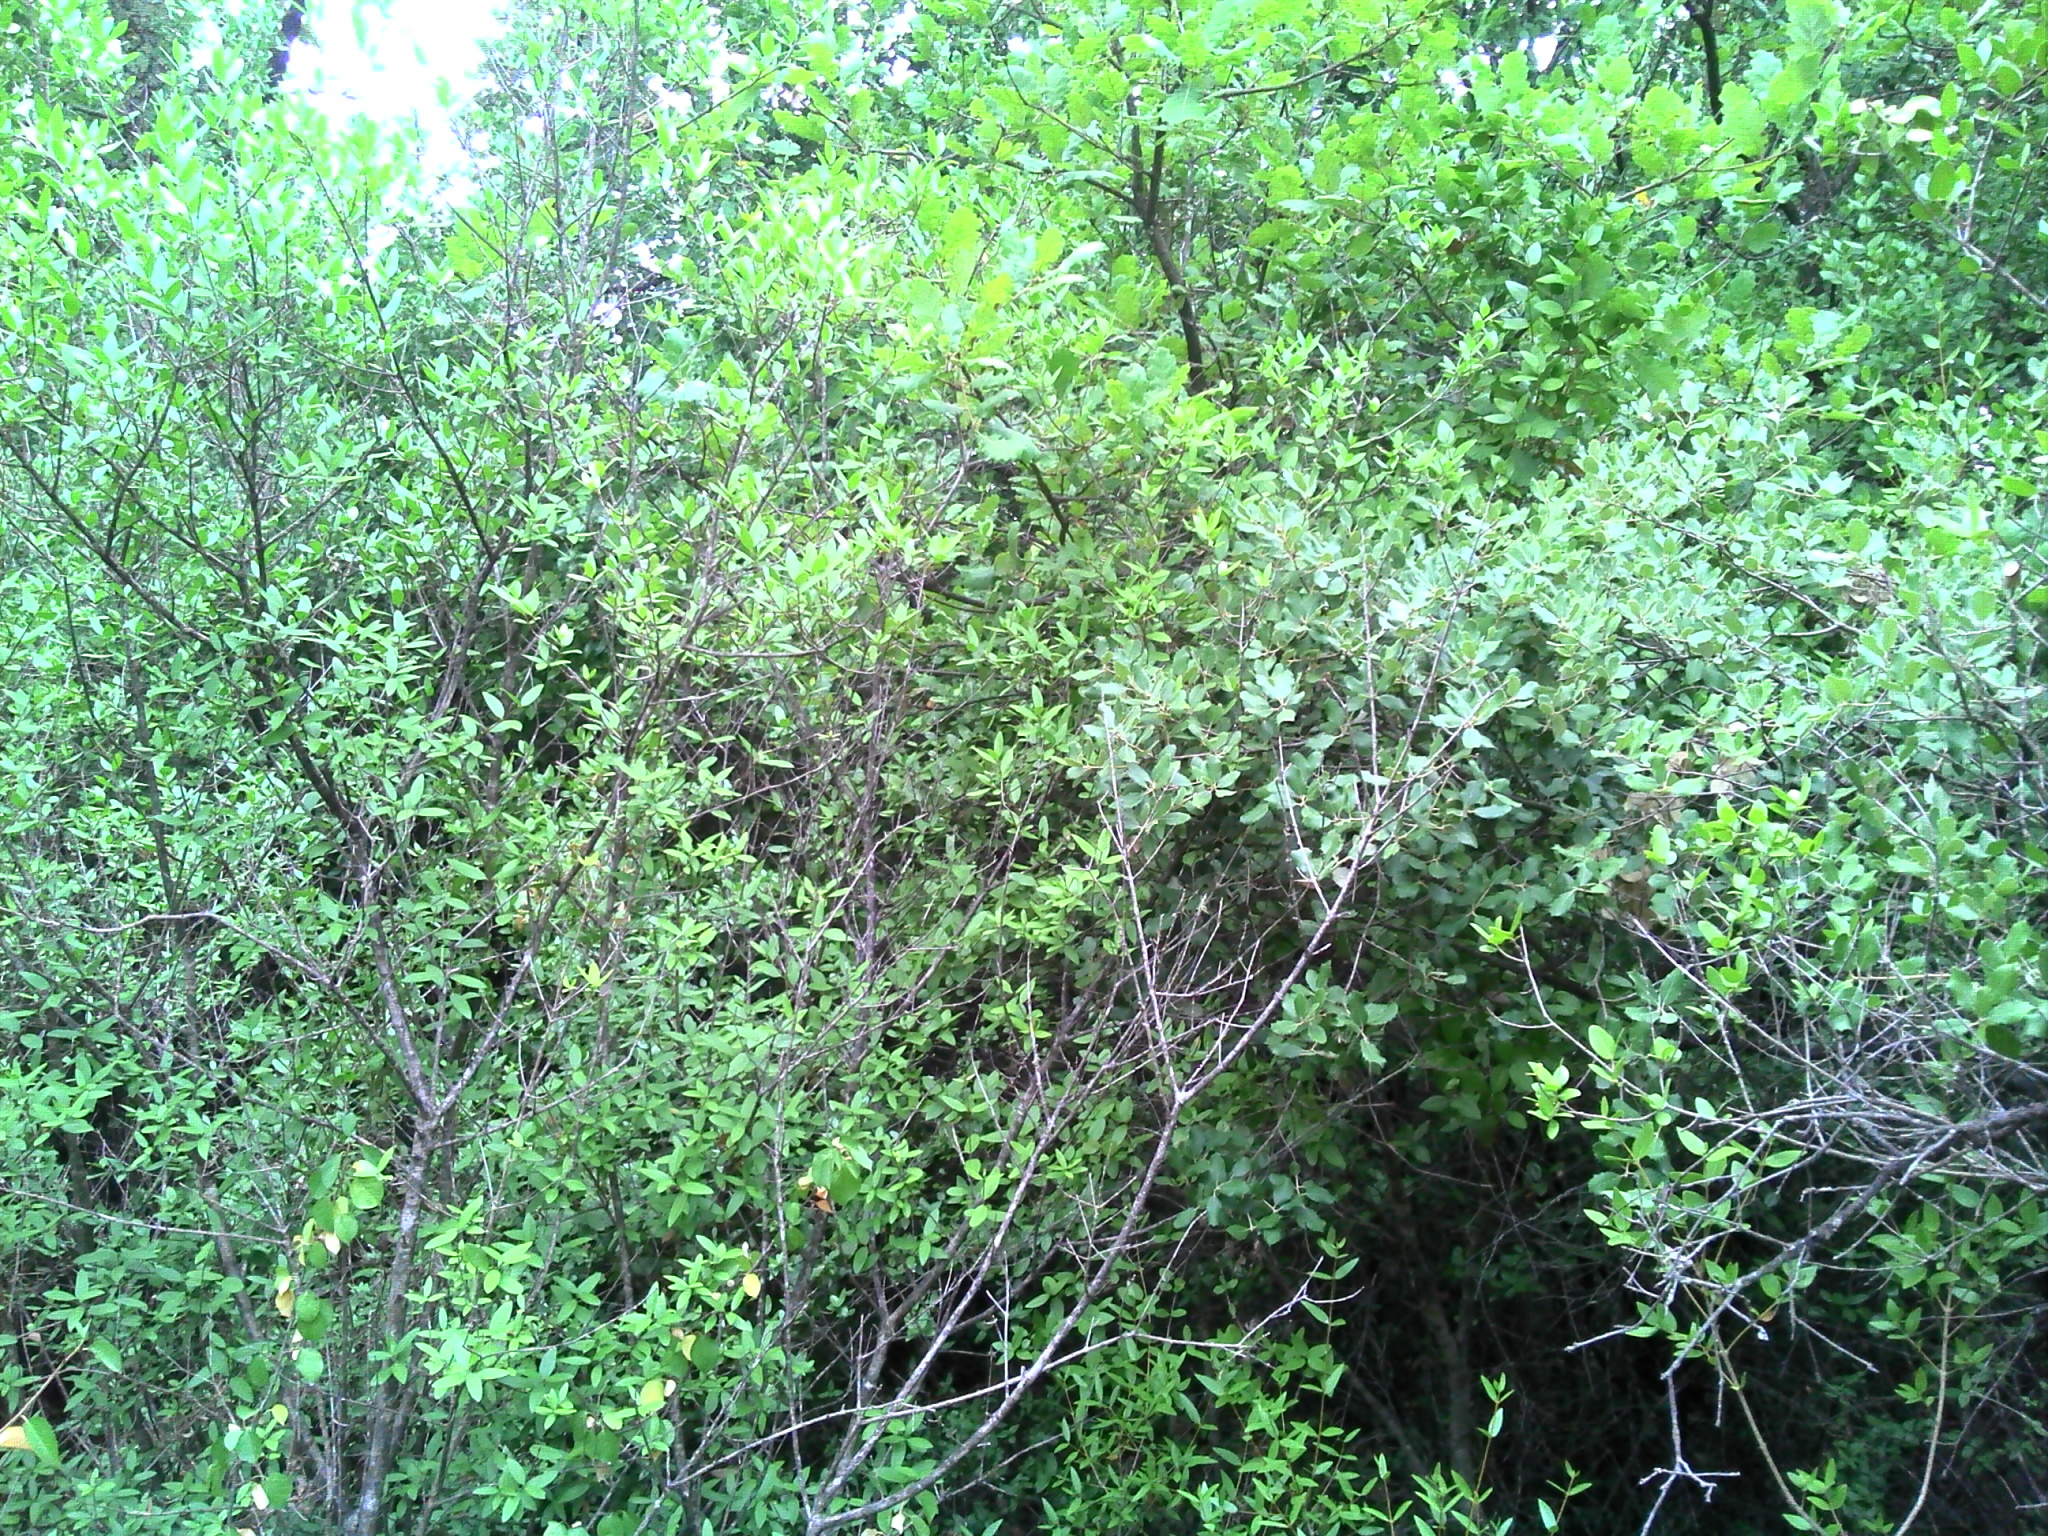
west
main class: Woodland
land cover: Broadleaved woodland
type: broadleaved evergreen forest
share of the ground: > 75 %
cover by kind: broadleaved forest trees 80 %, shrubs 10 %, herbaceous plants 10 %
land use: Semi-natural and natural areas not in use
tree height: > 5 m
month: July
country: FR
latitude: 43.9398
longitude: 3.9658
